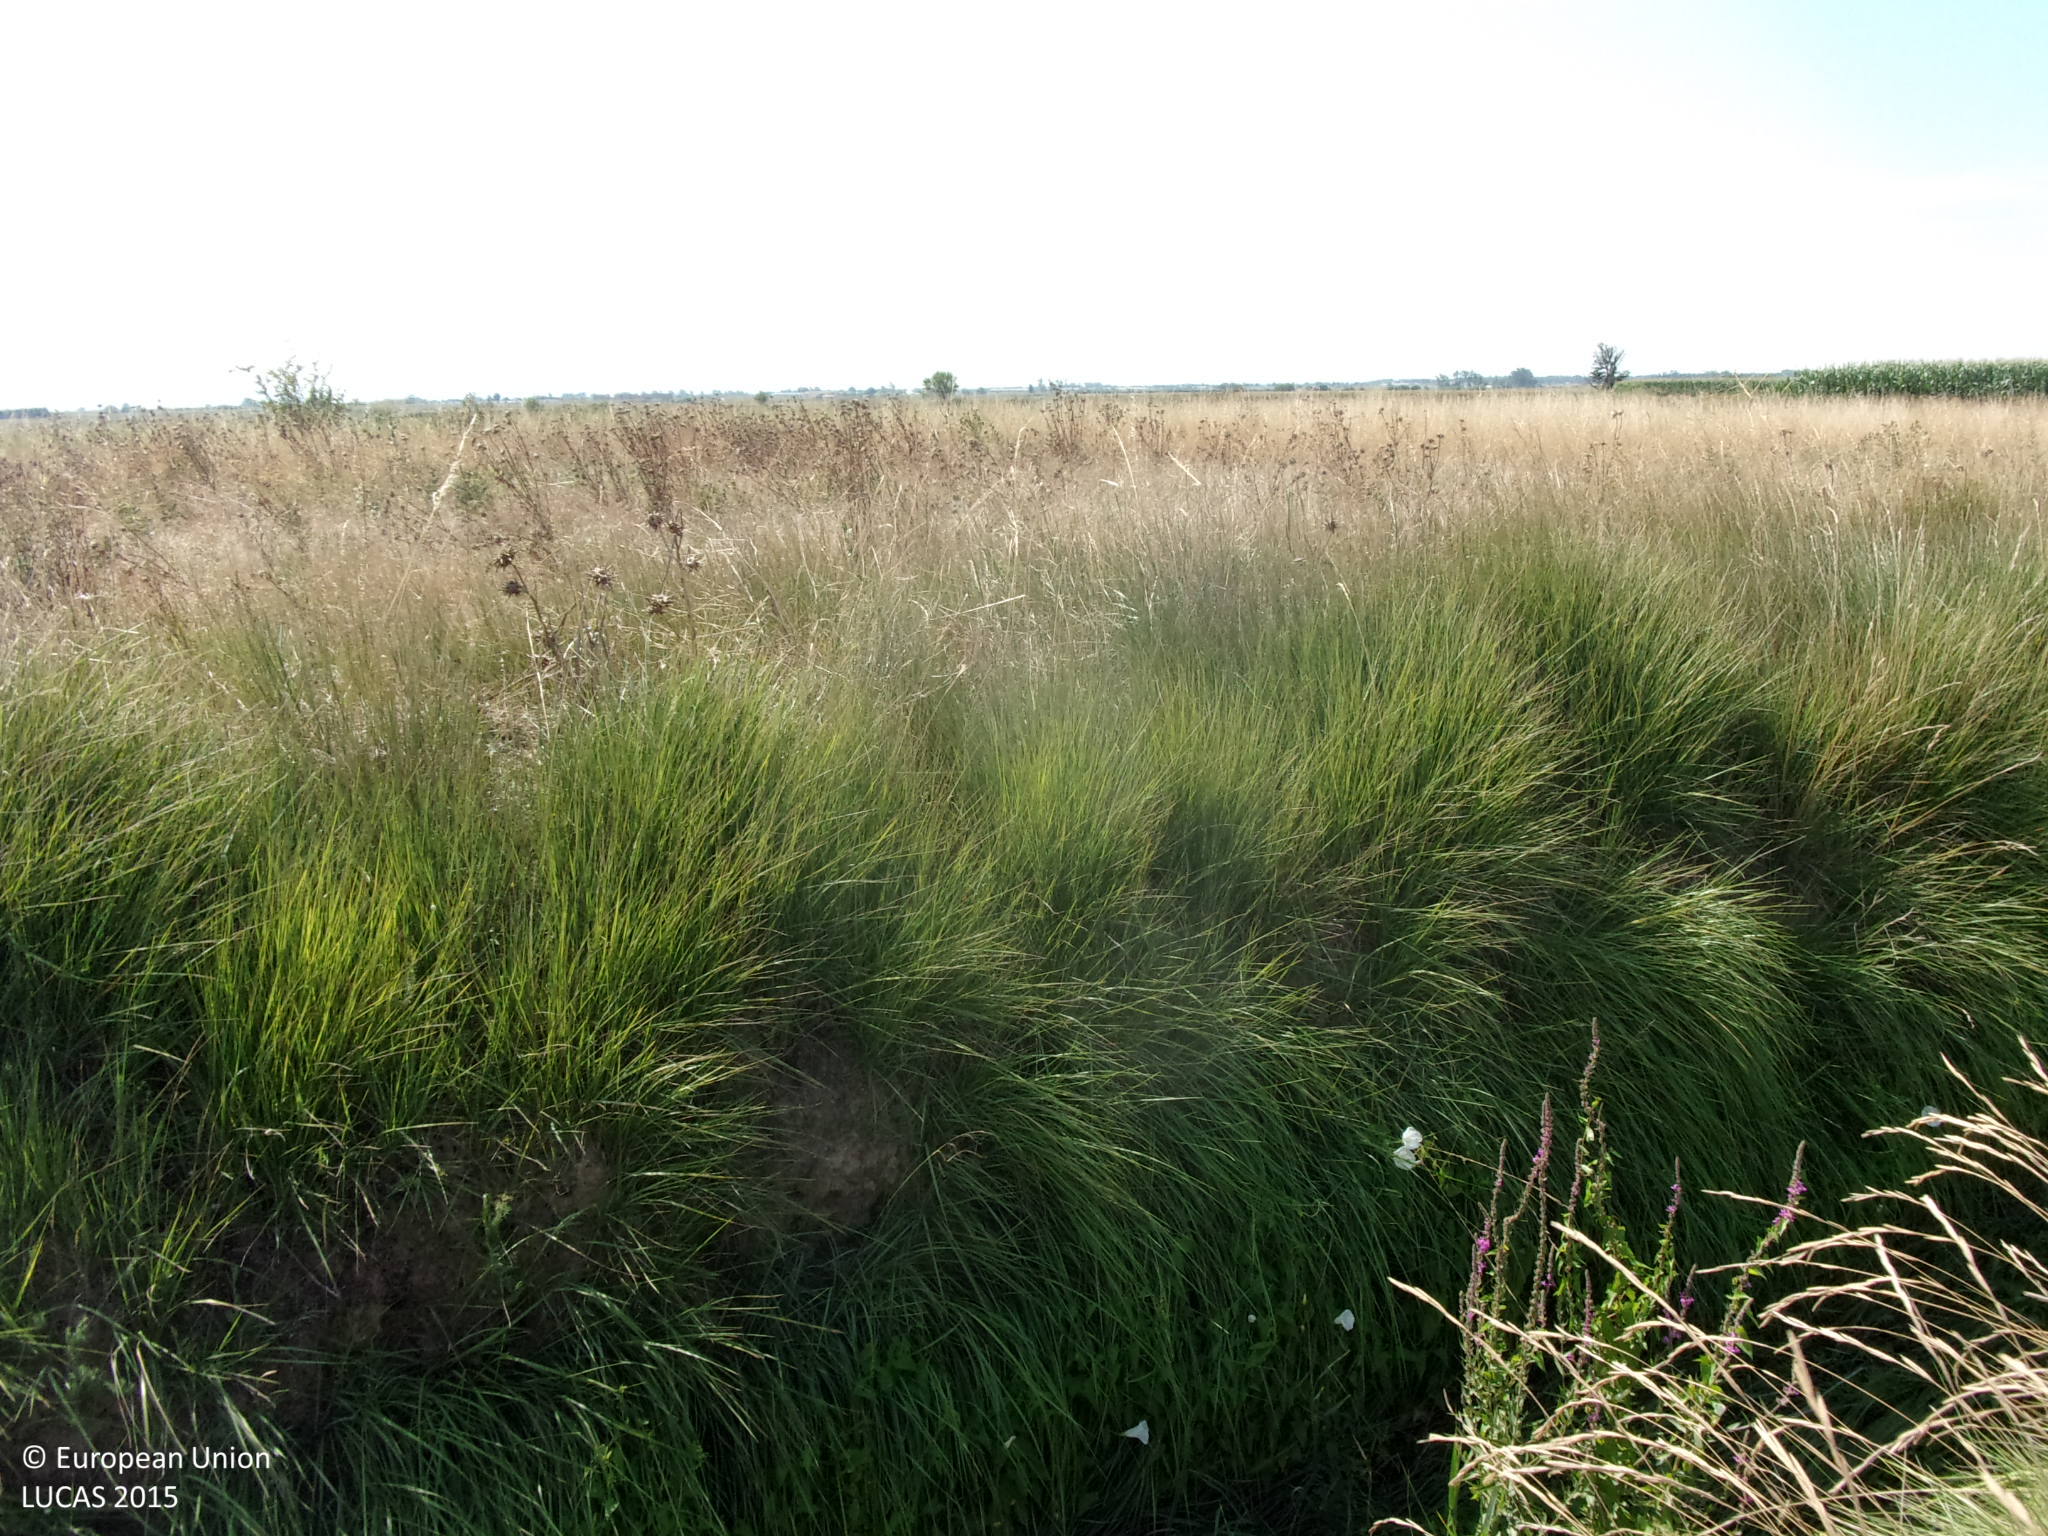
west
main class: Cropland
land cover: Barley
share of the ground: < 10 %
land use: Agriculture (excluding fallow land and kitchen gardens)
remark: Harvested field
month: August
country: ES
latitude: 42.1637
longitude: -1.1521
